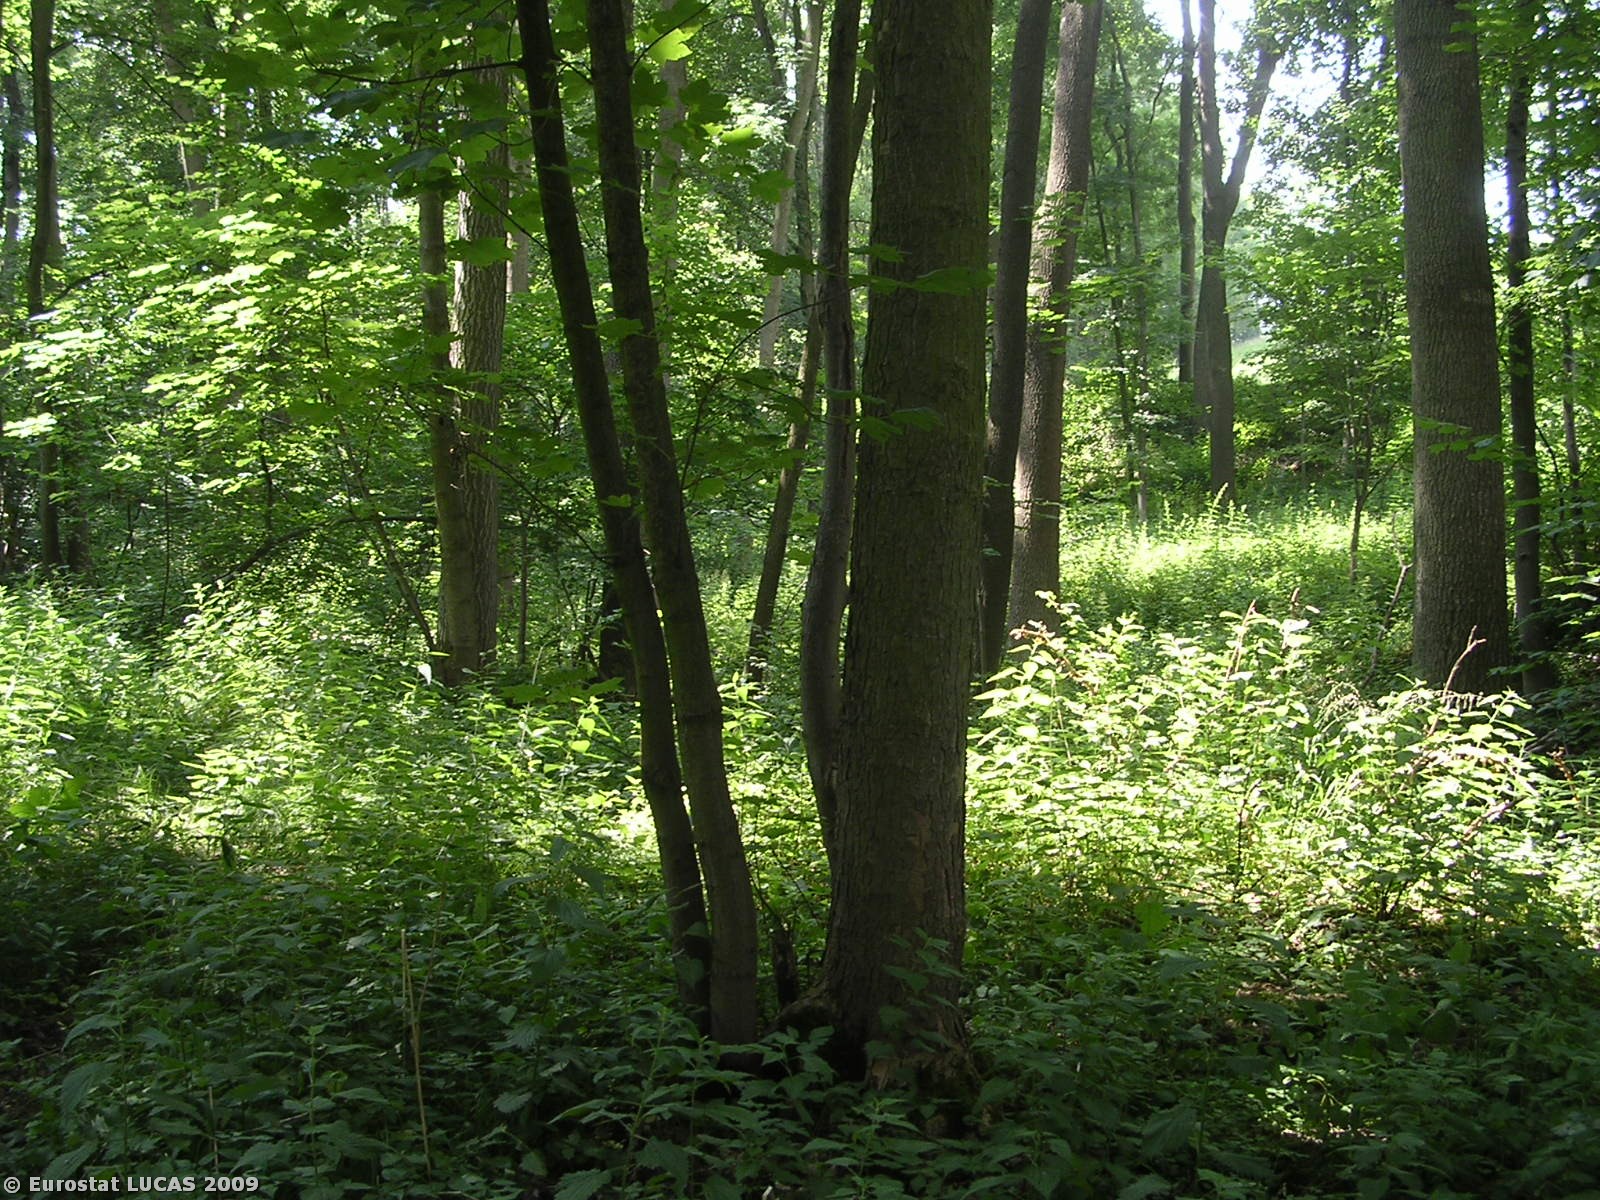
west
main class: Woodland
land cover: Broadleaved woodland
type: mesophytic deciduous forest
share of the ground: > 75 %
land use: Forestry
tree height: > 5 m
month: June
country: CZ
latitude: 50.7167
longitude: 14.2646
